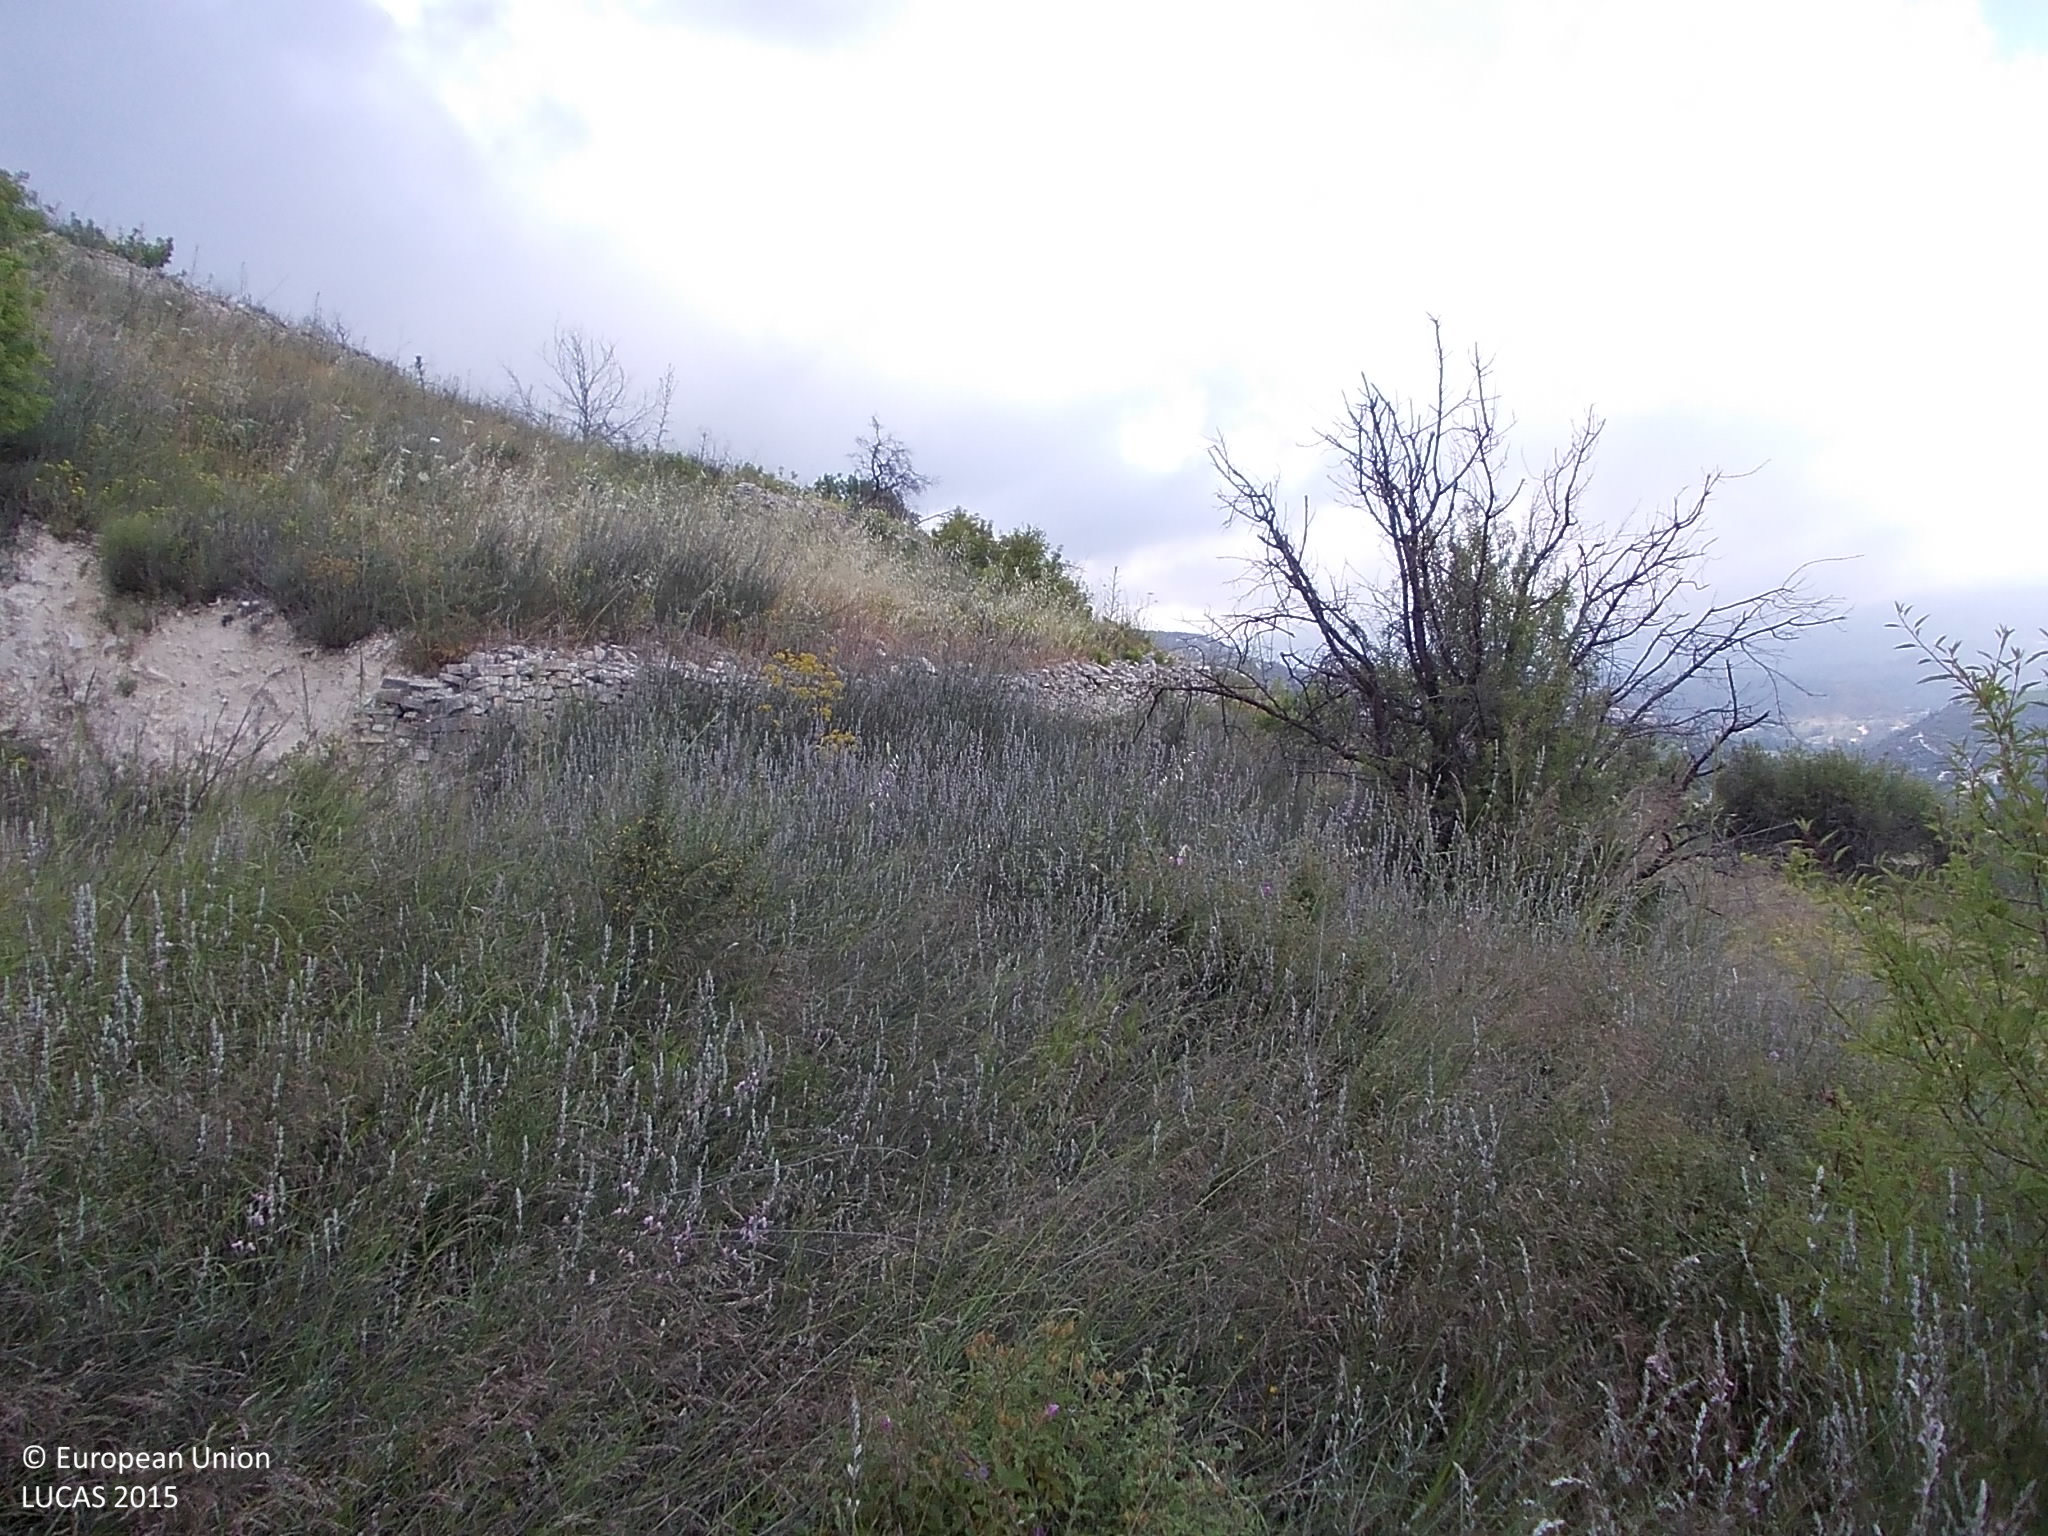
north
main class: Shrubland
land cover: Shrubland without tree cover
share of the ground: 10 - 25 %
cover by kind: herbaceous plants 75 %, shrubs 25 %
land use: Semi-natural and natural areas not in use
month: May
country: CY
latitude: 34.8425
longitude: 32.8094
